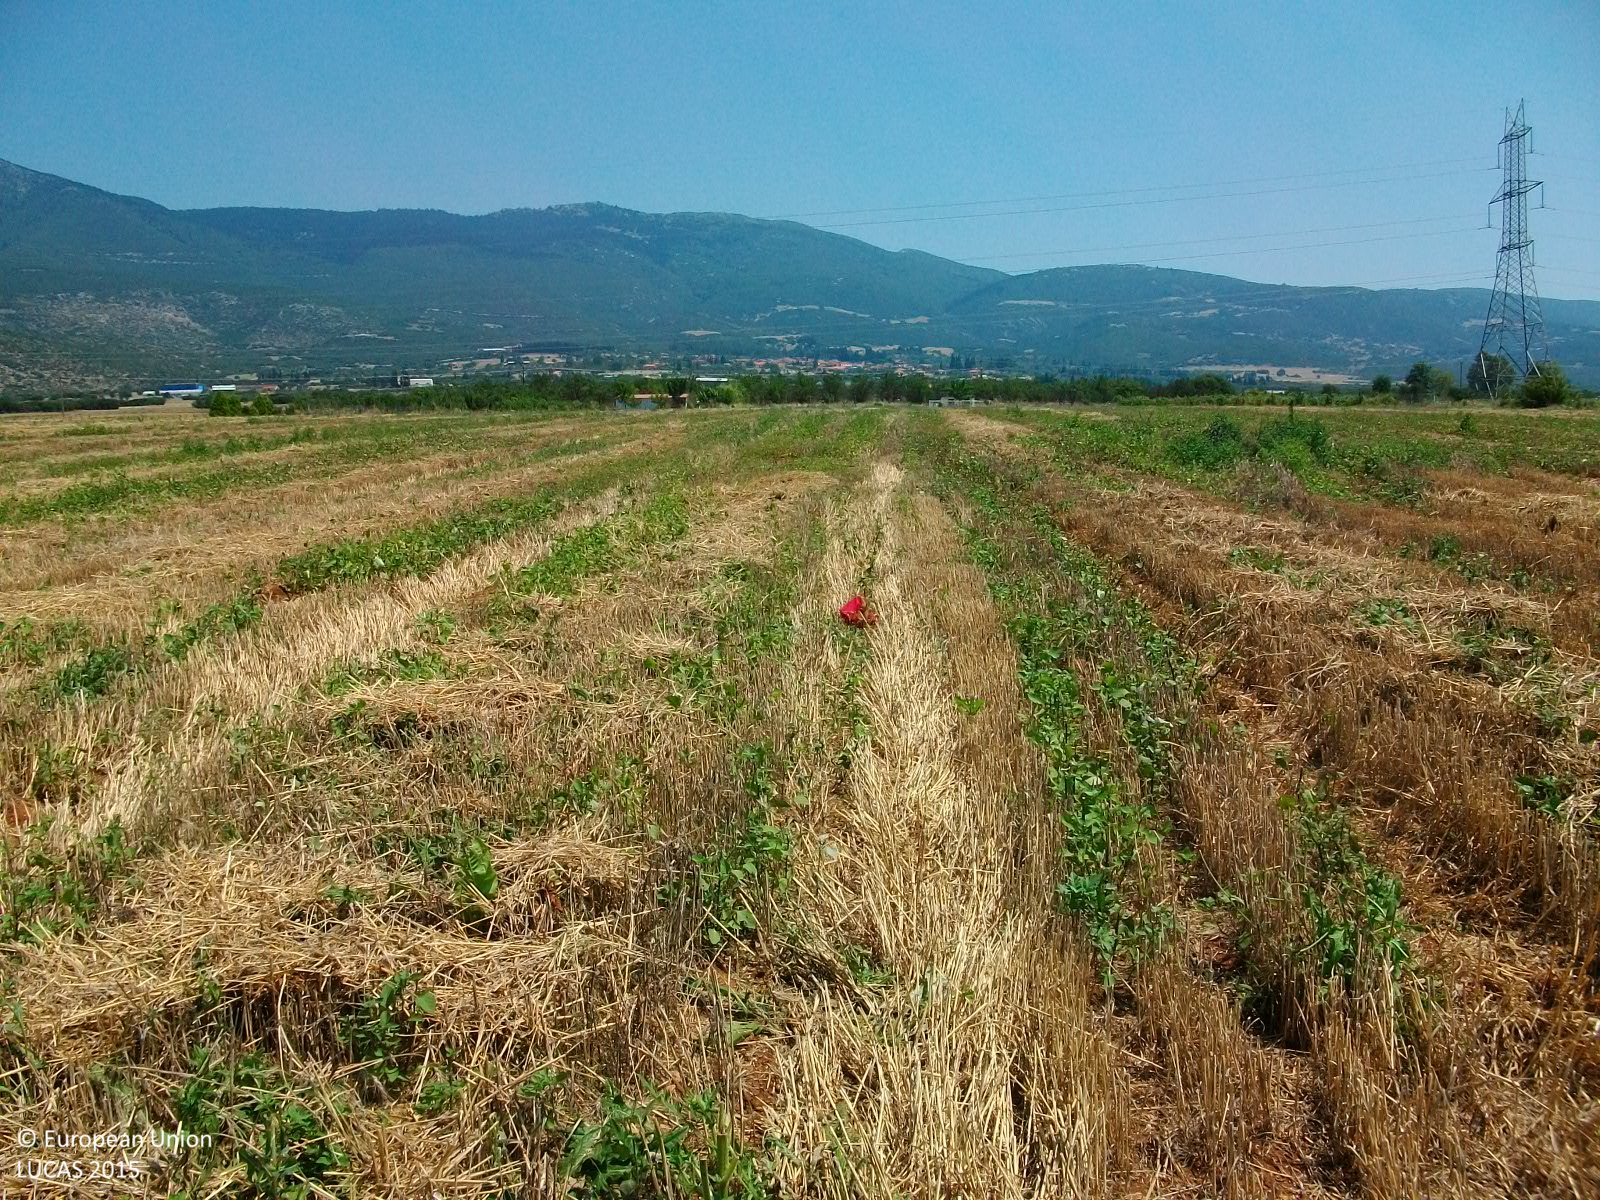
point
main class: Cropland
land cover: Durum wheat
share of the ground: > 75 %
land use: Agriculture (excluding fallow land and kitchen gardens)
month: July
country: GR
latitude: 38.6902
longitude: 22.5449
